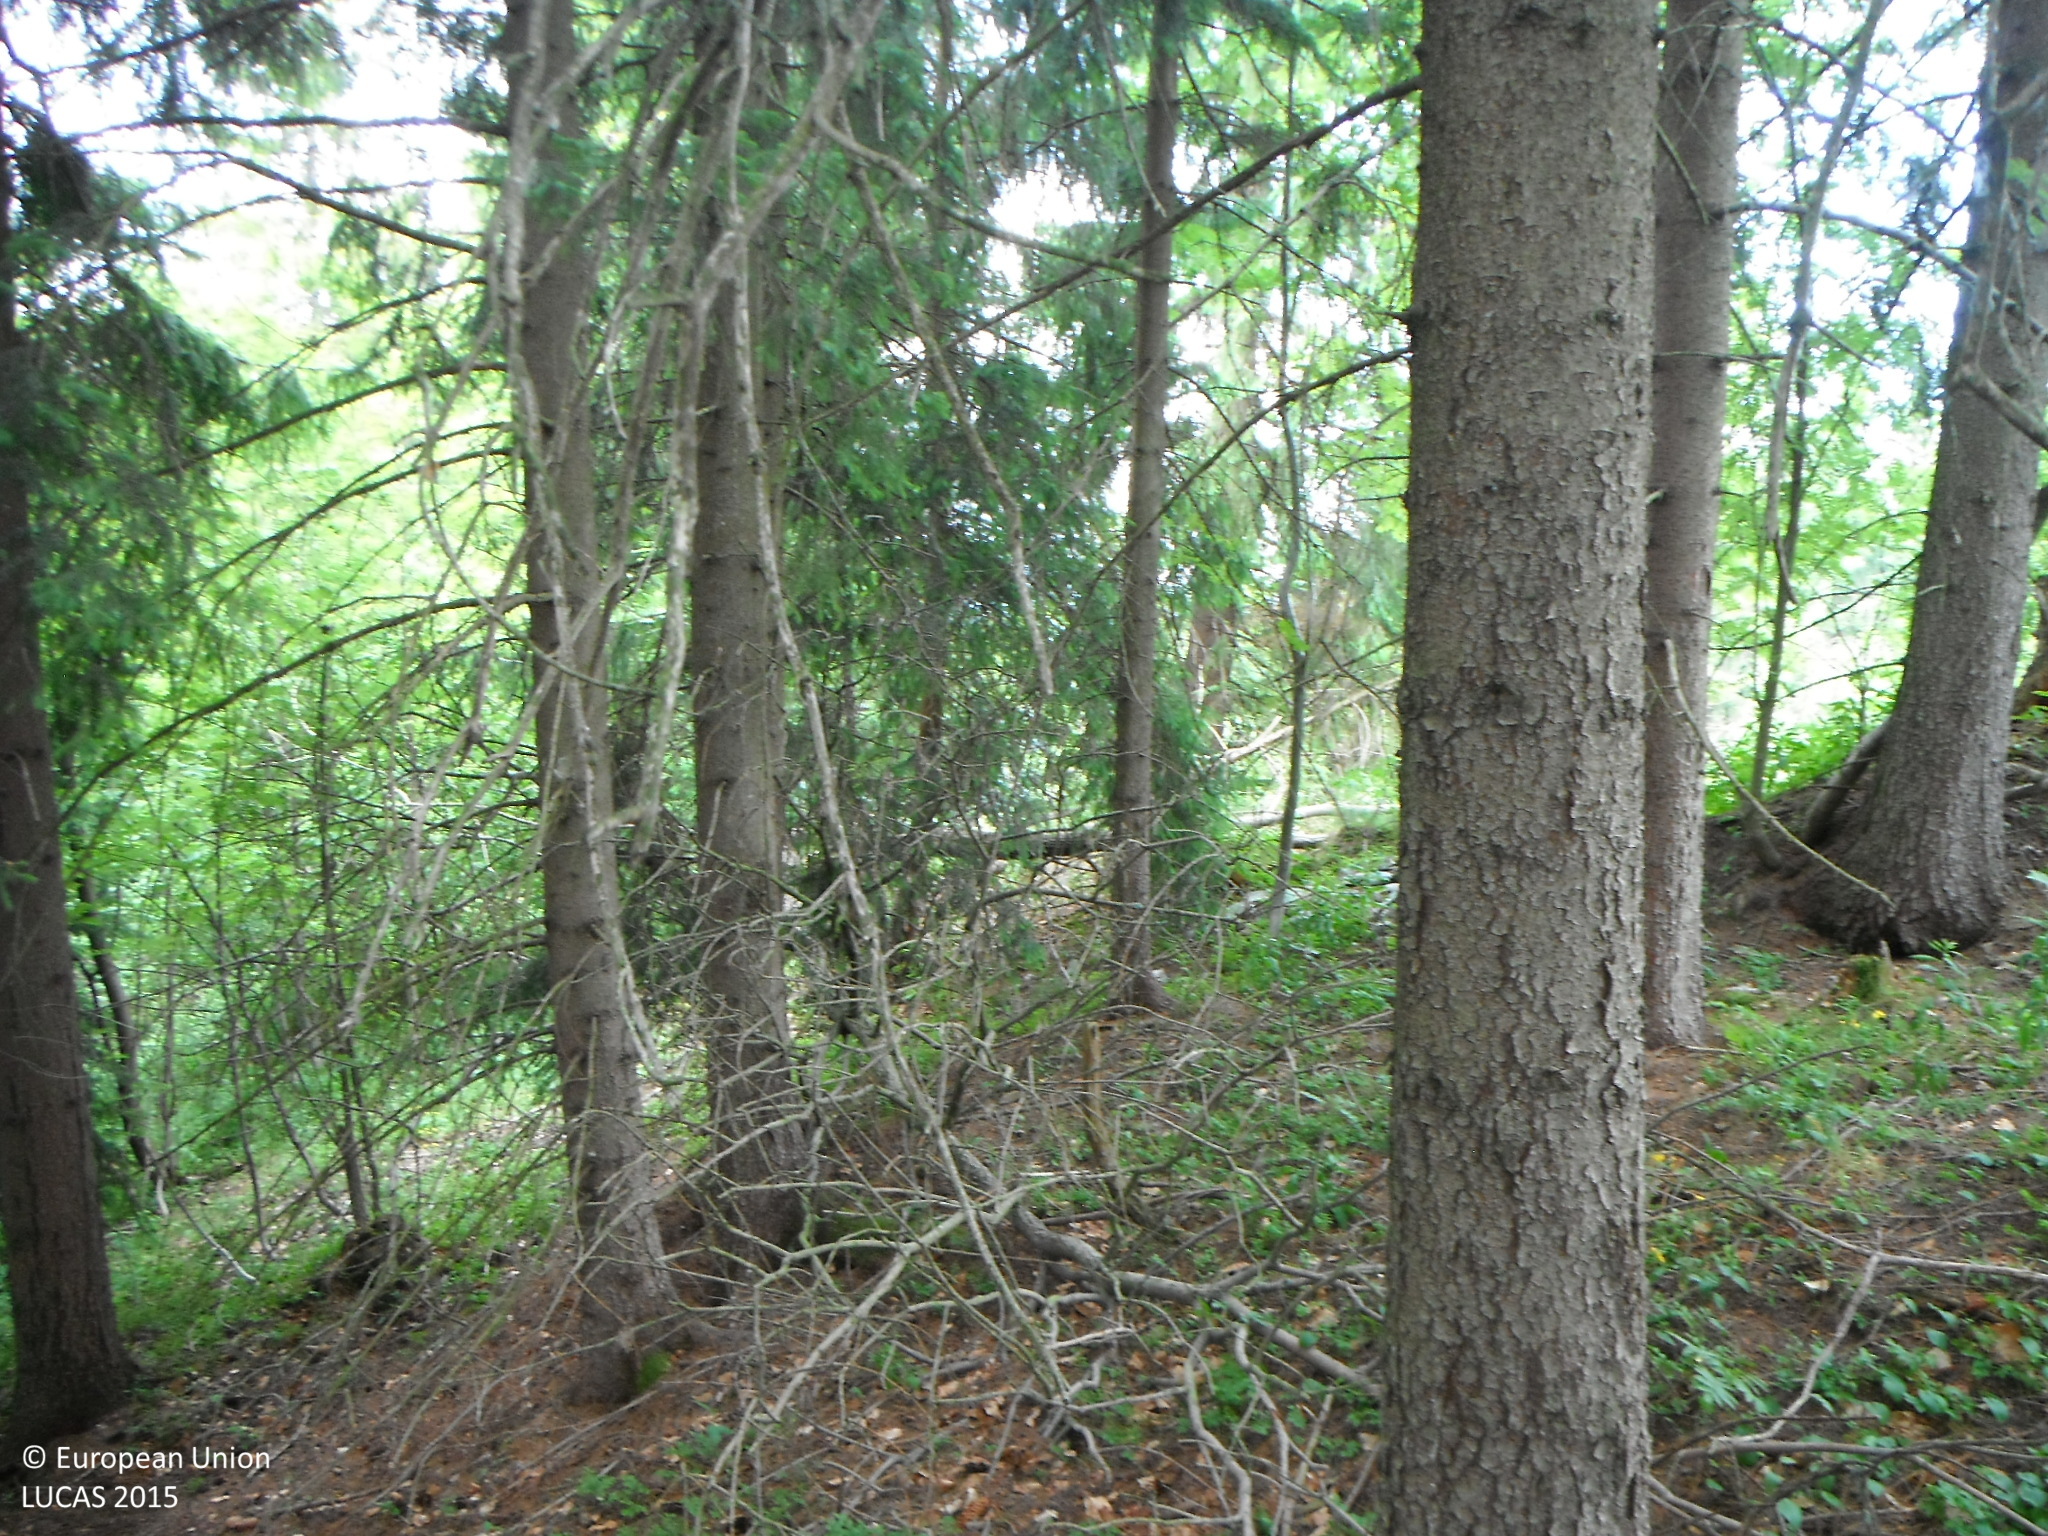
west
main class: Woodland
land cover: Spruce dominated coniferous woodland
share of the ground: > 75 %
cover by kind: coniferous forest trees 90 %, broadleaved forest trees 10 %
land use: Forestry
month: July
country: SK
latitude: 49.4074
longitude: 19.2722
